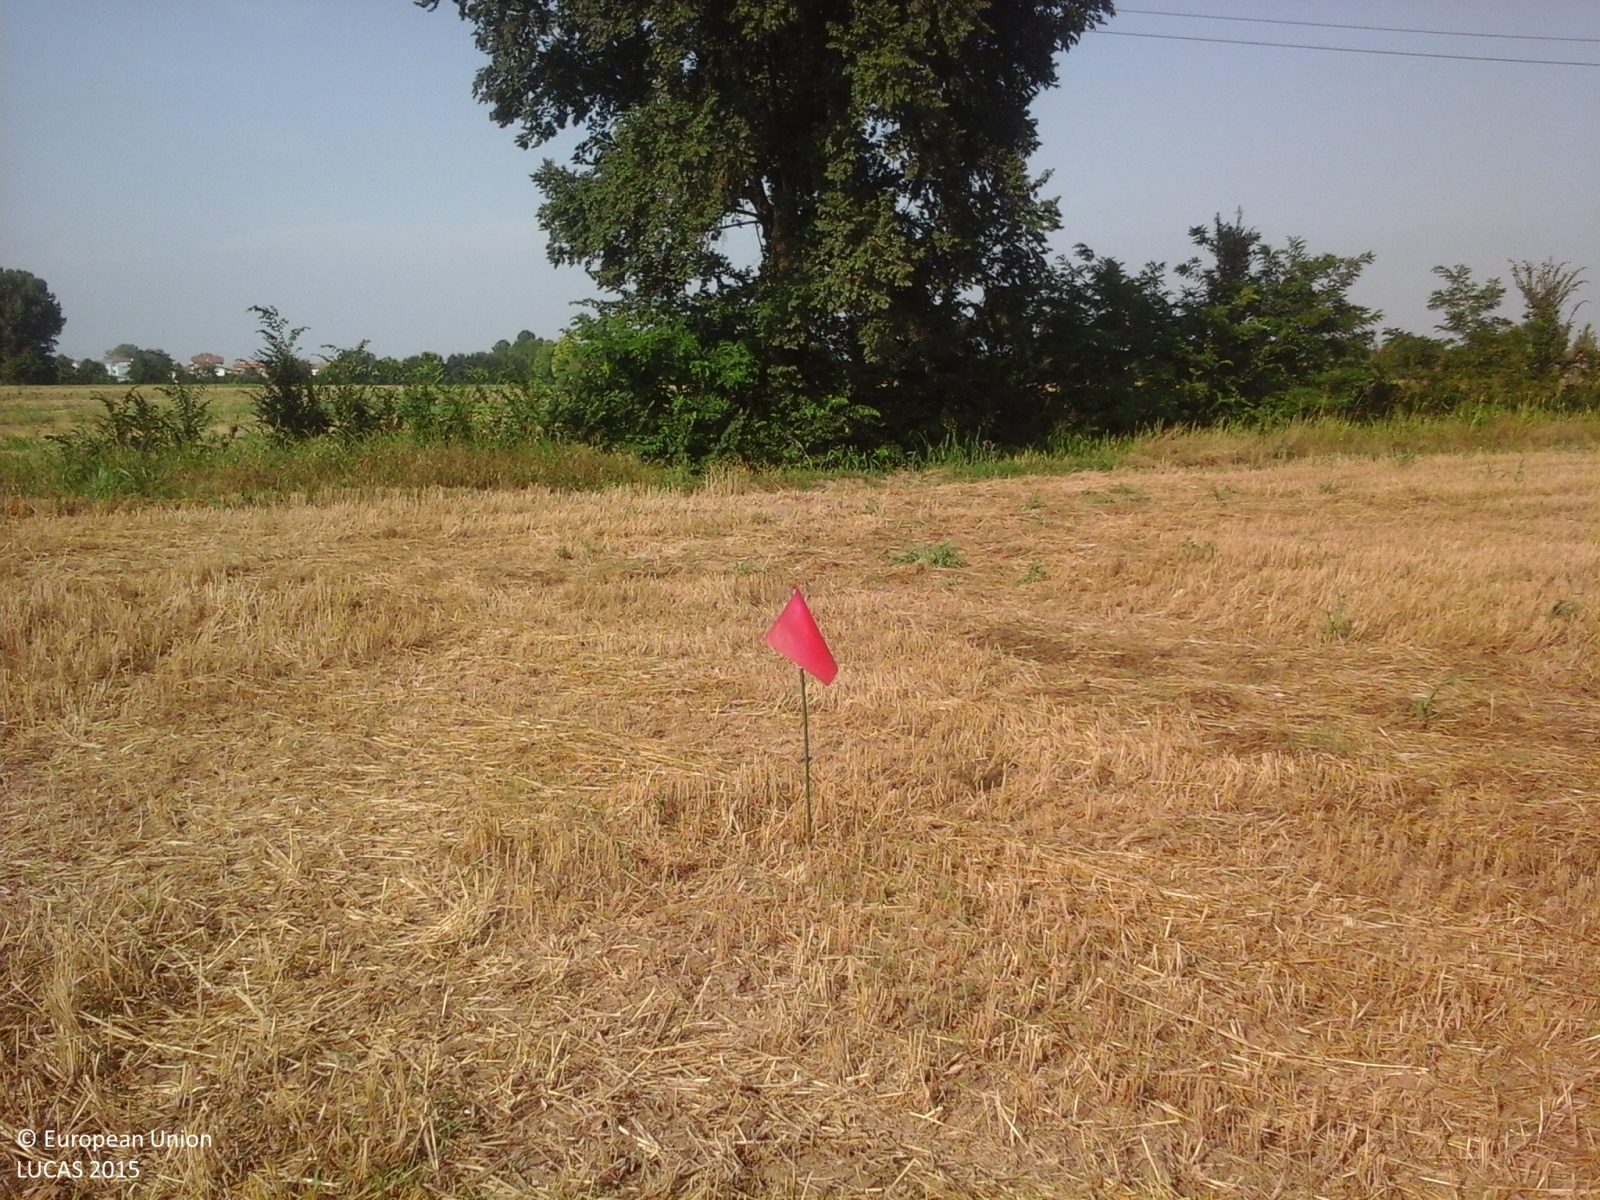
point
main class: Cropland
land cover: Common wheat
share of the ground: > 75 %
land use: Agriculture (excluding fallow land and kitchen gardens)
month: July
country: IT
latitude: 45.1767
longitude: 10.8256
